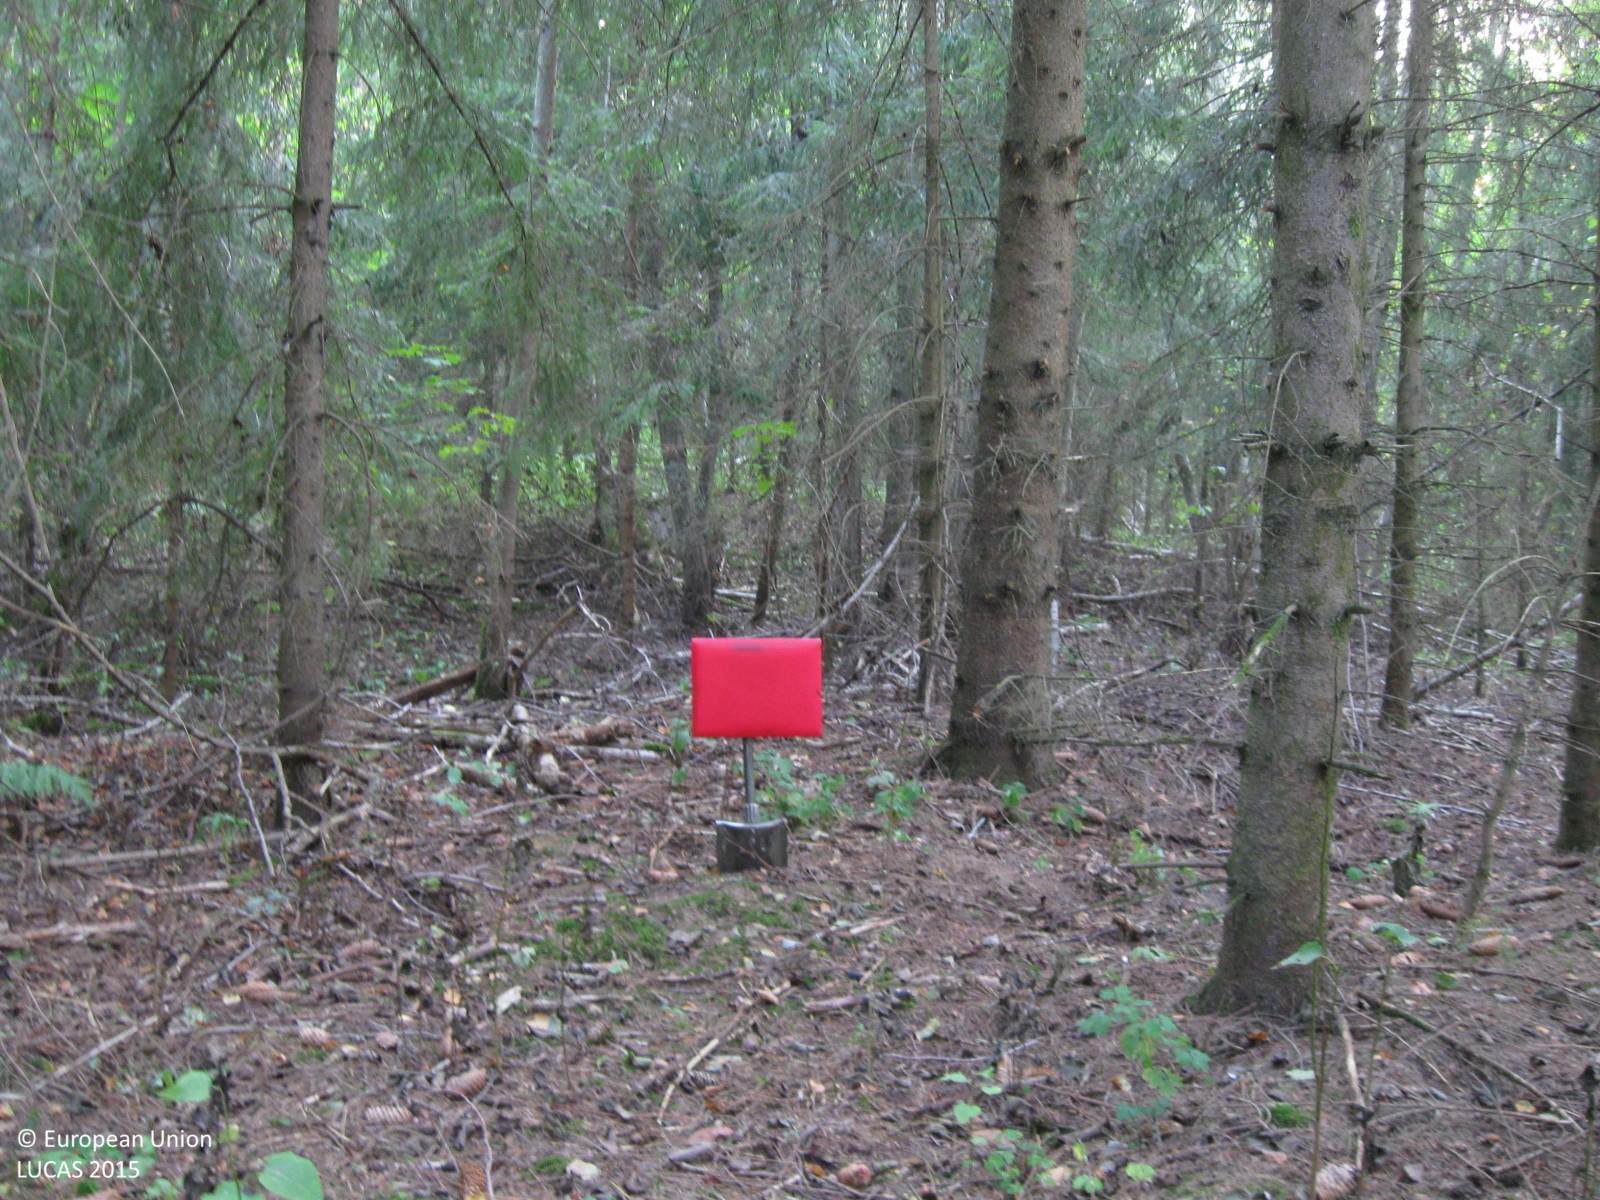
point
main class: Woodland
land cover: Spruce dominated mixed woodland
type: hemiboreal forest and nemoral coniferous forest and mixed broadleaved-coniferous forest
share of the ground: > 75 %
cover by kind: coniferous forest trees 55 %, broadleaved forest trees 35 %, herbaceous plants 10 %
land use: Forestry
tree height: > 5 m
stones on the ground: < 10 %
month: September
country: LT
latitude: 55.0837
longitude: 23.1866
